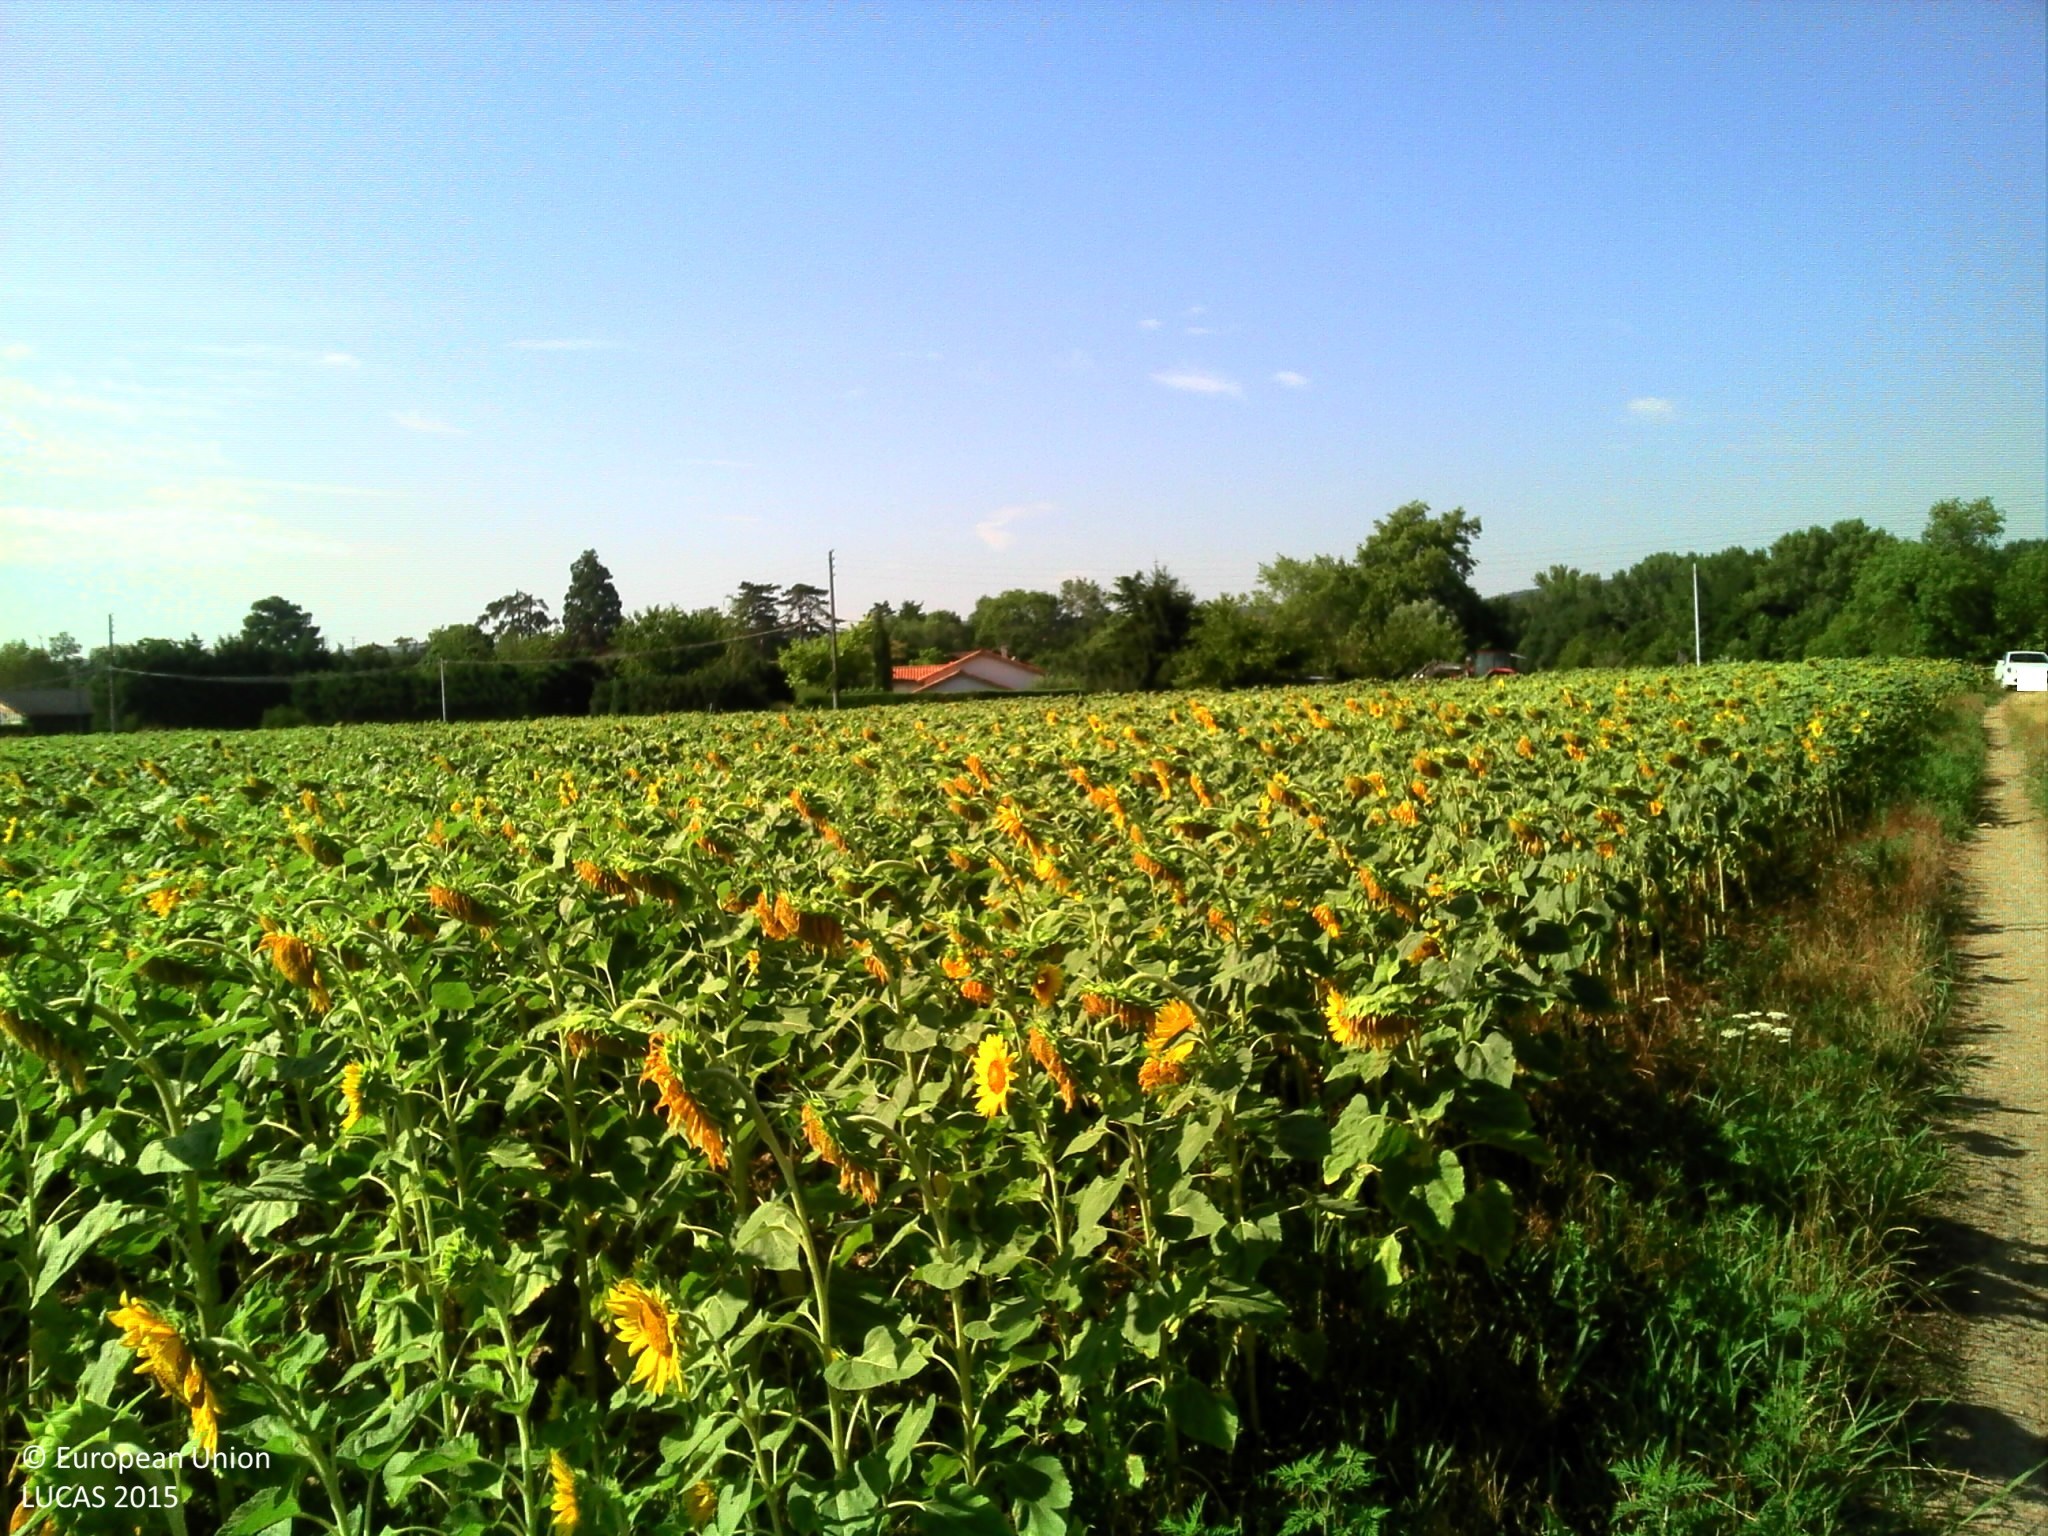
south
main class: Cropland
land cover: Sunflower
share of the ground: > 75 %
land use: Agriculture (excluding fallow land and kitchen gardens)
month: July
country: FR
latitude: 45.5099
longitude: 4.9483
